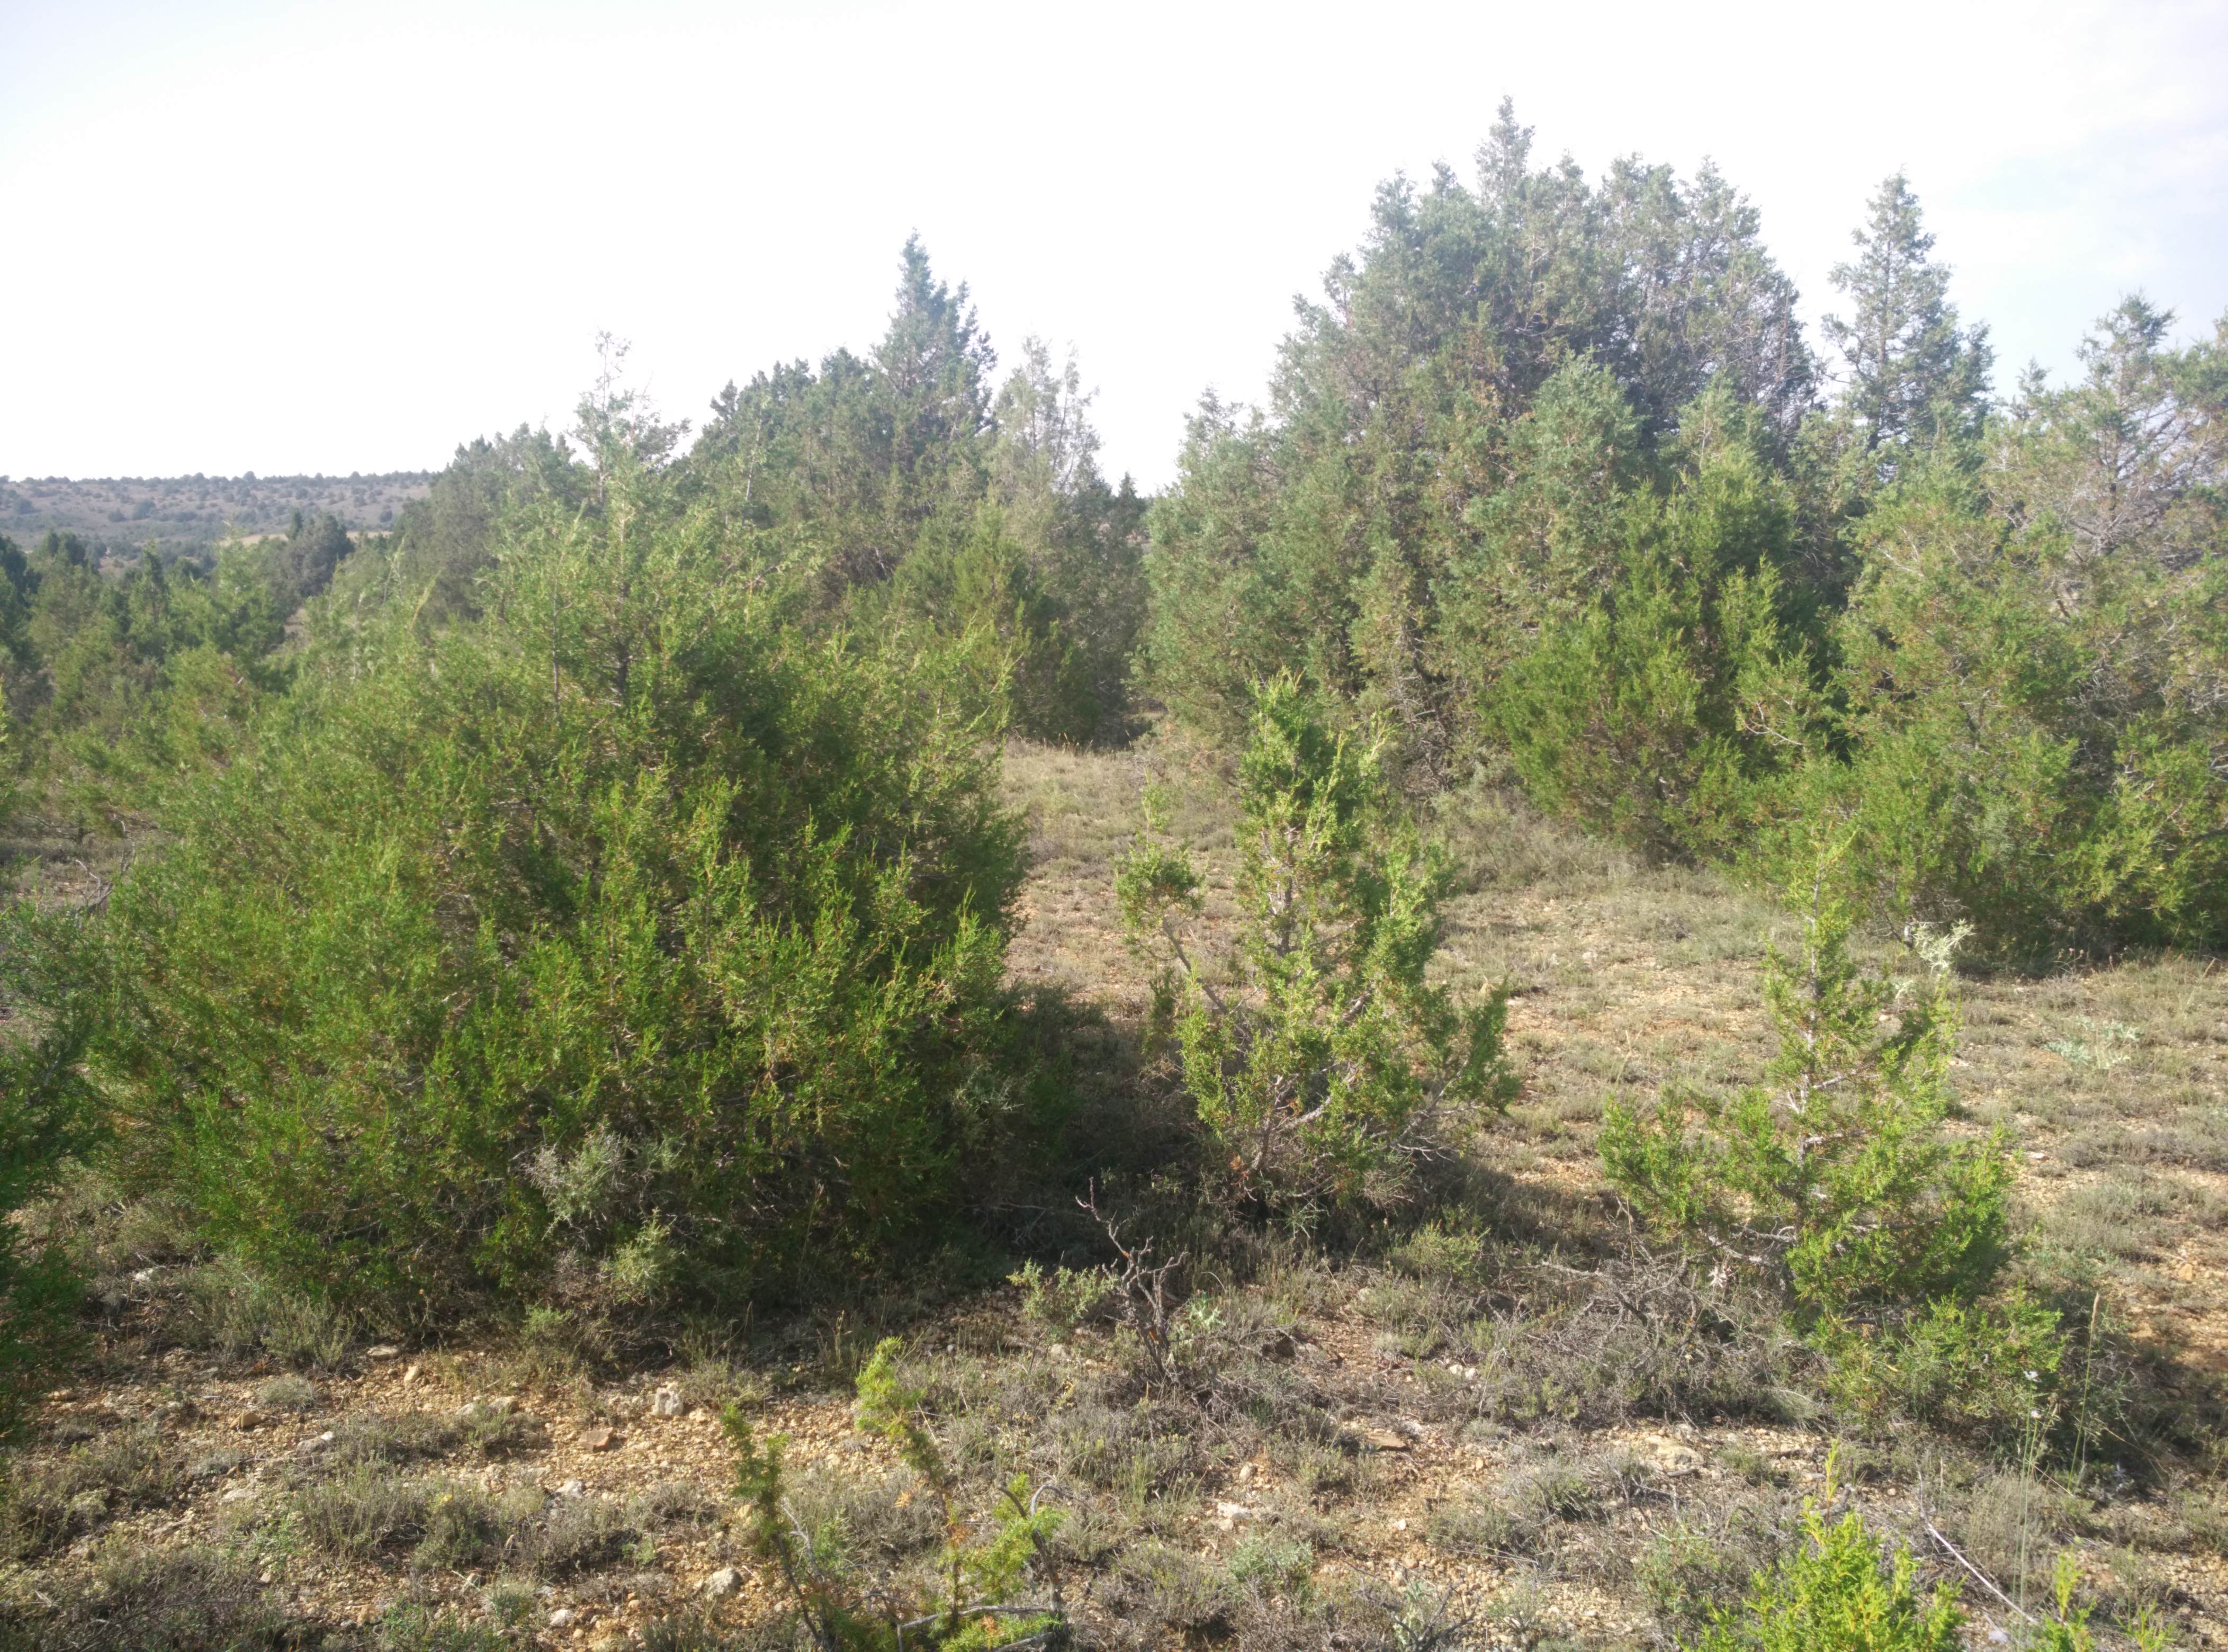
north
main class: Woodland
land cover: Other coniferous woodland
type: coniferous forest of the mediterranean region
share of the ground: 10 - 25 %
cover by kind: unconsolidated bare surface 50 %, shrubs 25 %, coniferous forest trees 20 %, herbaceous plants 5 %
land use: Semi-natural and natural areas not in use
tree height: > 5 m
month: July
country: ES
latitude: 41.0495
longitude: -2.1023
